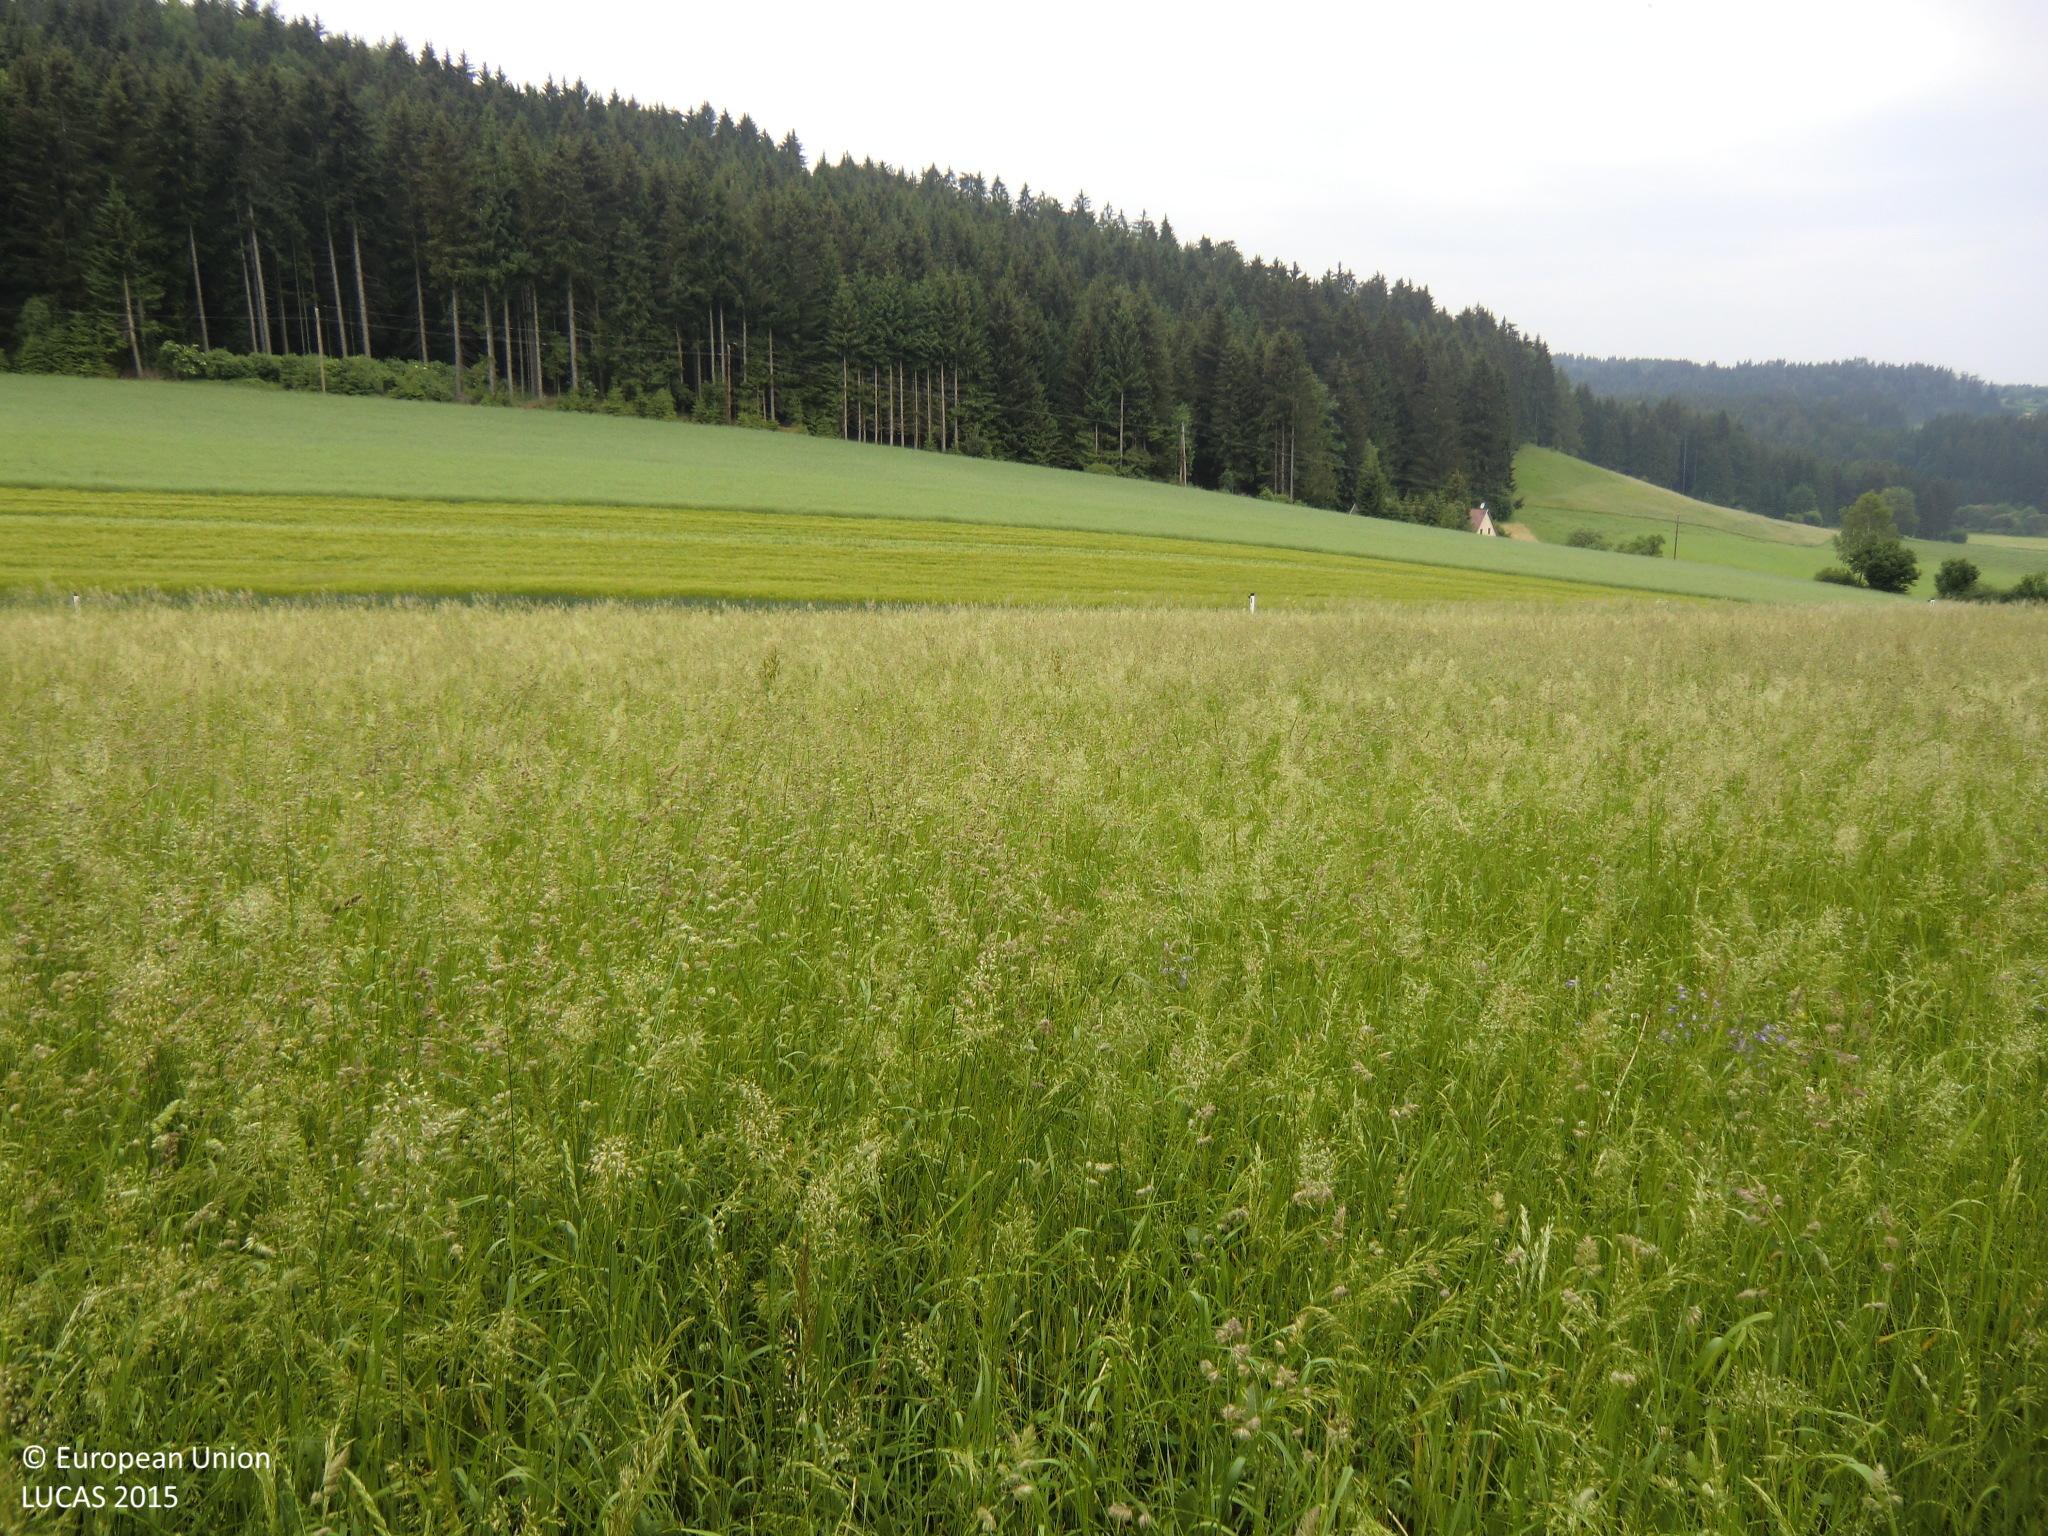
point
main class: Cropland
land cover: Temporary grasslands
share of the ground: > 75 %
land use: Agriculture (excluding fallow land and kitchen gardens)
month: June
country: AT
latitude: 48.5979
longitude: 14.9781
